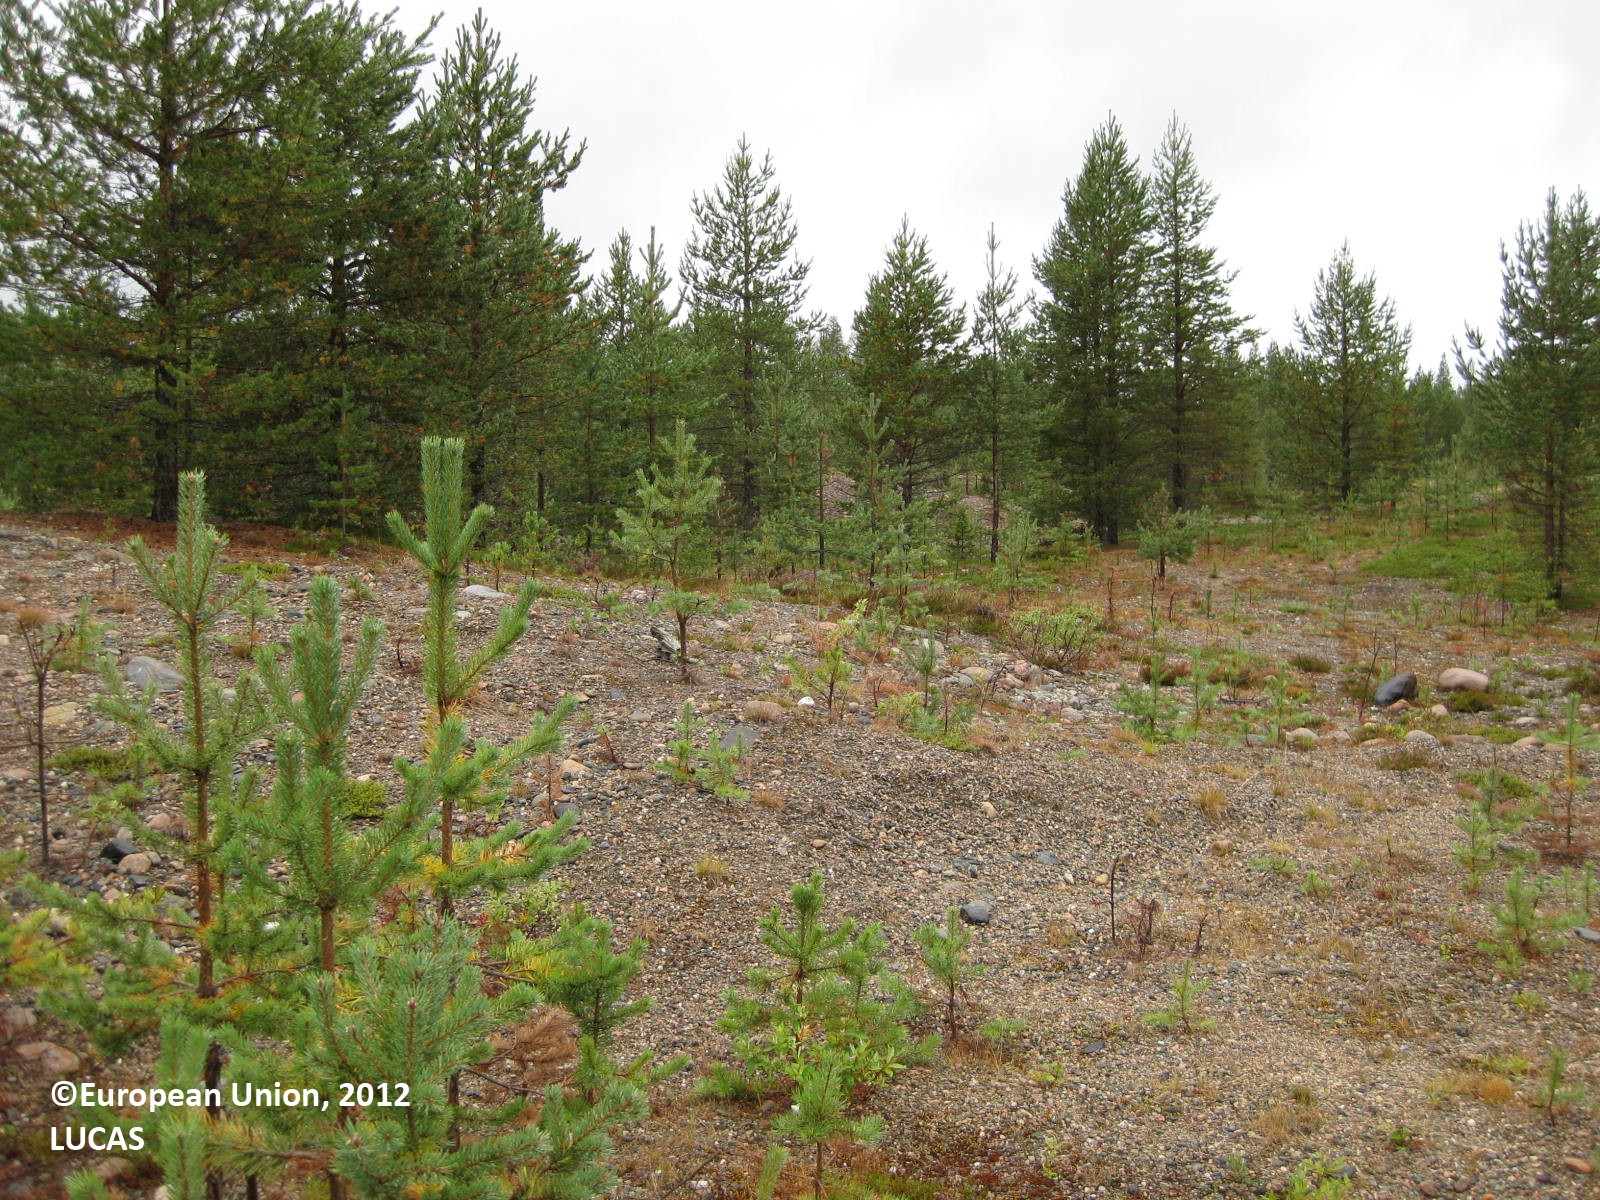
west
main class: Woodland
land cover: Pine dominated coniferous woodland
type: boreal forest
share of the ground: 10 - 25 %
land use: Forestry
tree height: < 5 m
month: August
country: FI
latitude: 66.1445
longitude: 28.4301
